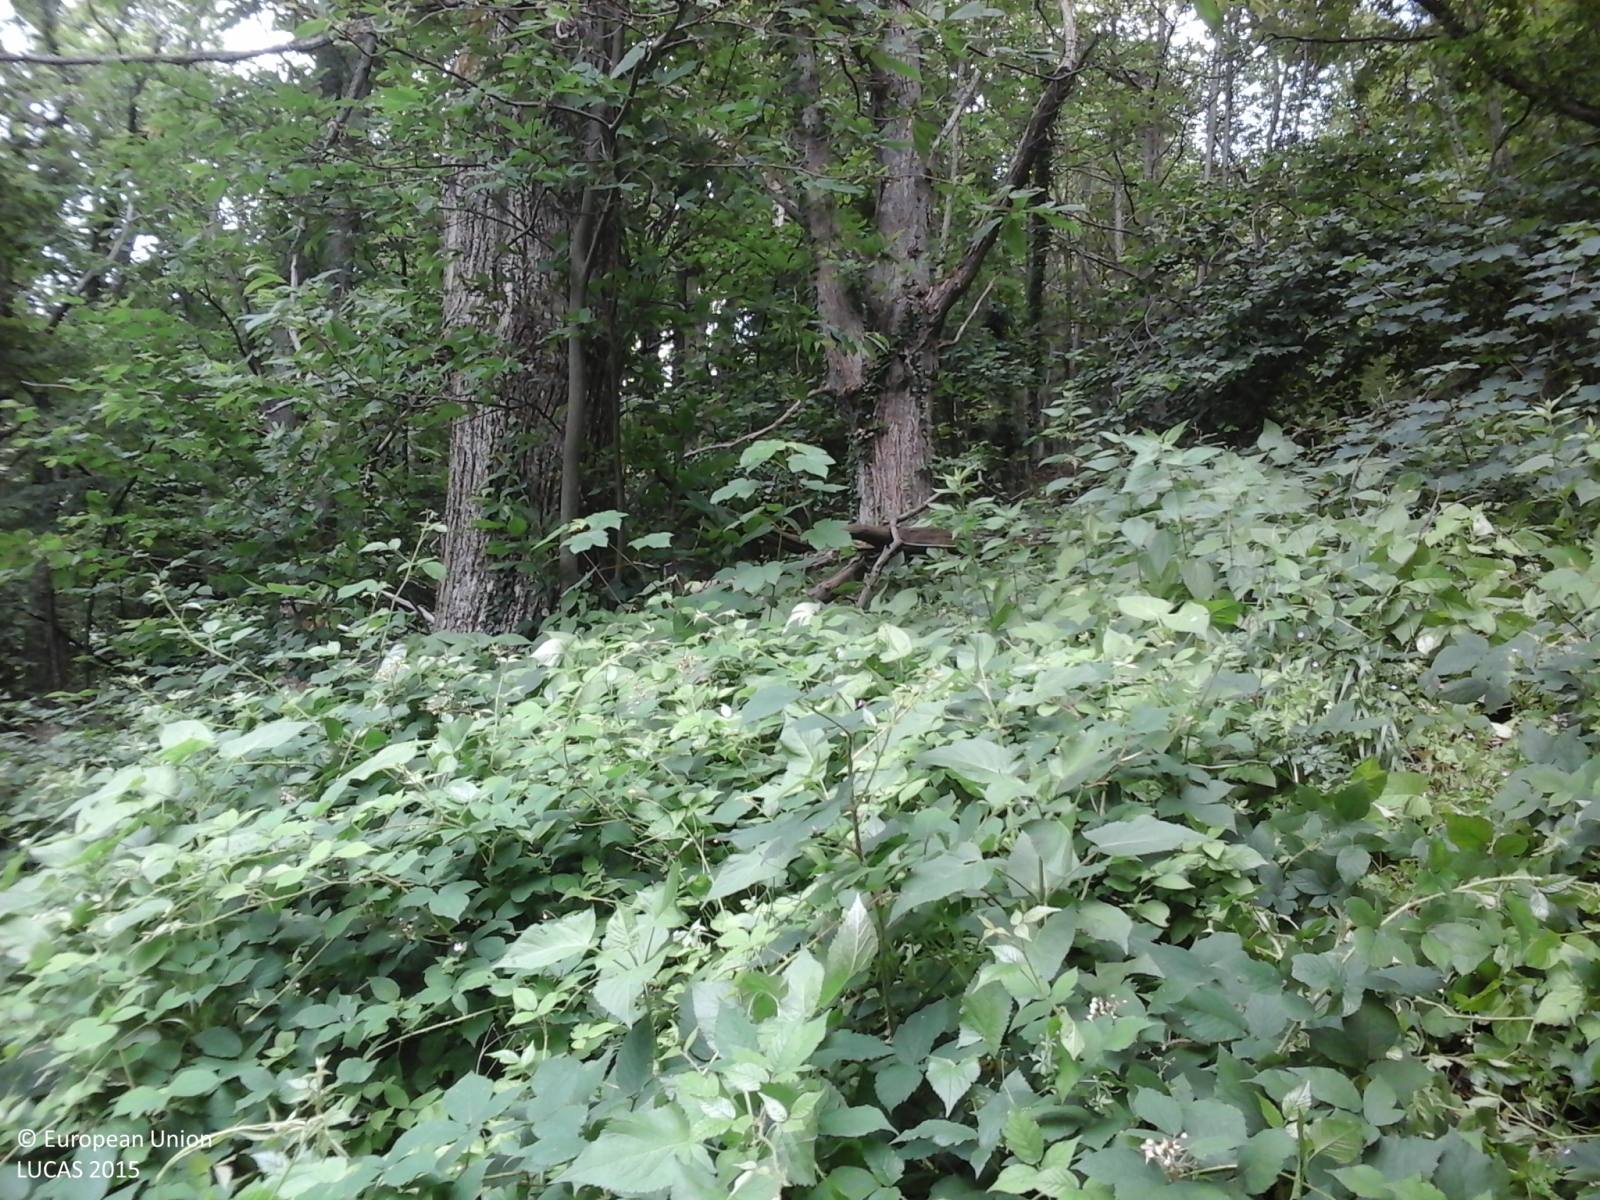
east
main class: Woodland
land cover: Broadleaved woodland
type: thermophilous deciduous forest
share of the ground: > 75 %
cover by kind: broadleaved forest trees 100 %
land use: Forestry
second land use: Other primary production
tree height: > 5 m
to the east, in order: Broadleaved woodland
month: June
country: IT
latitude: 42.8334
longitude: 13.3546
